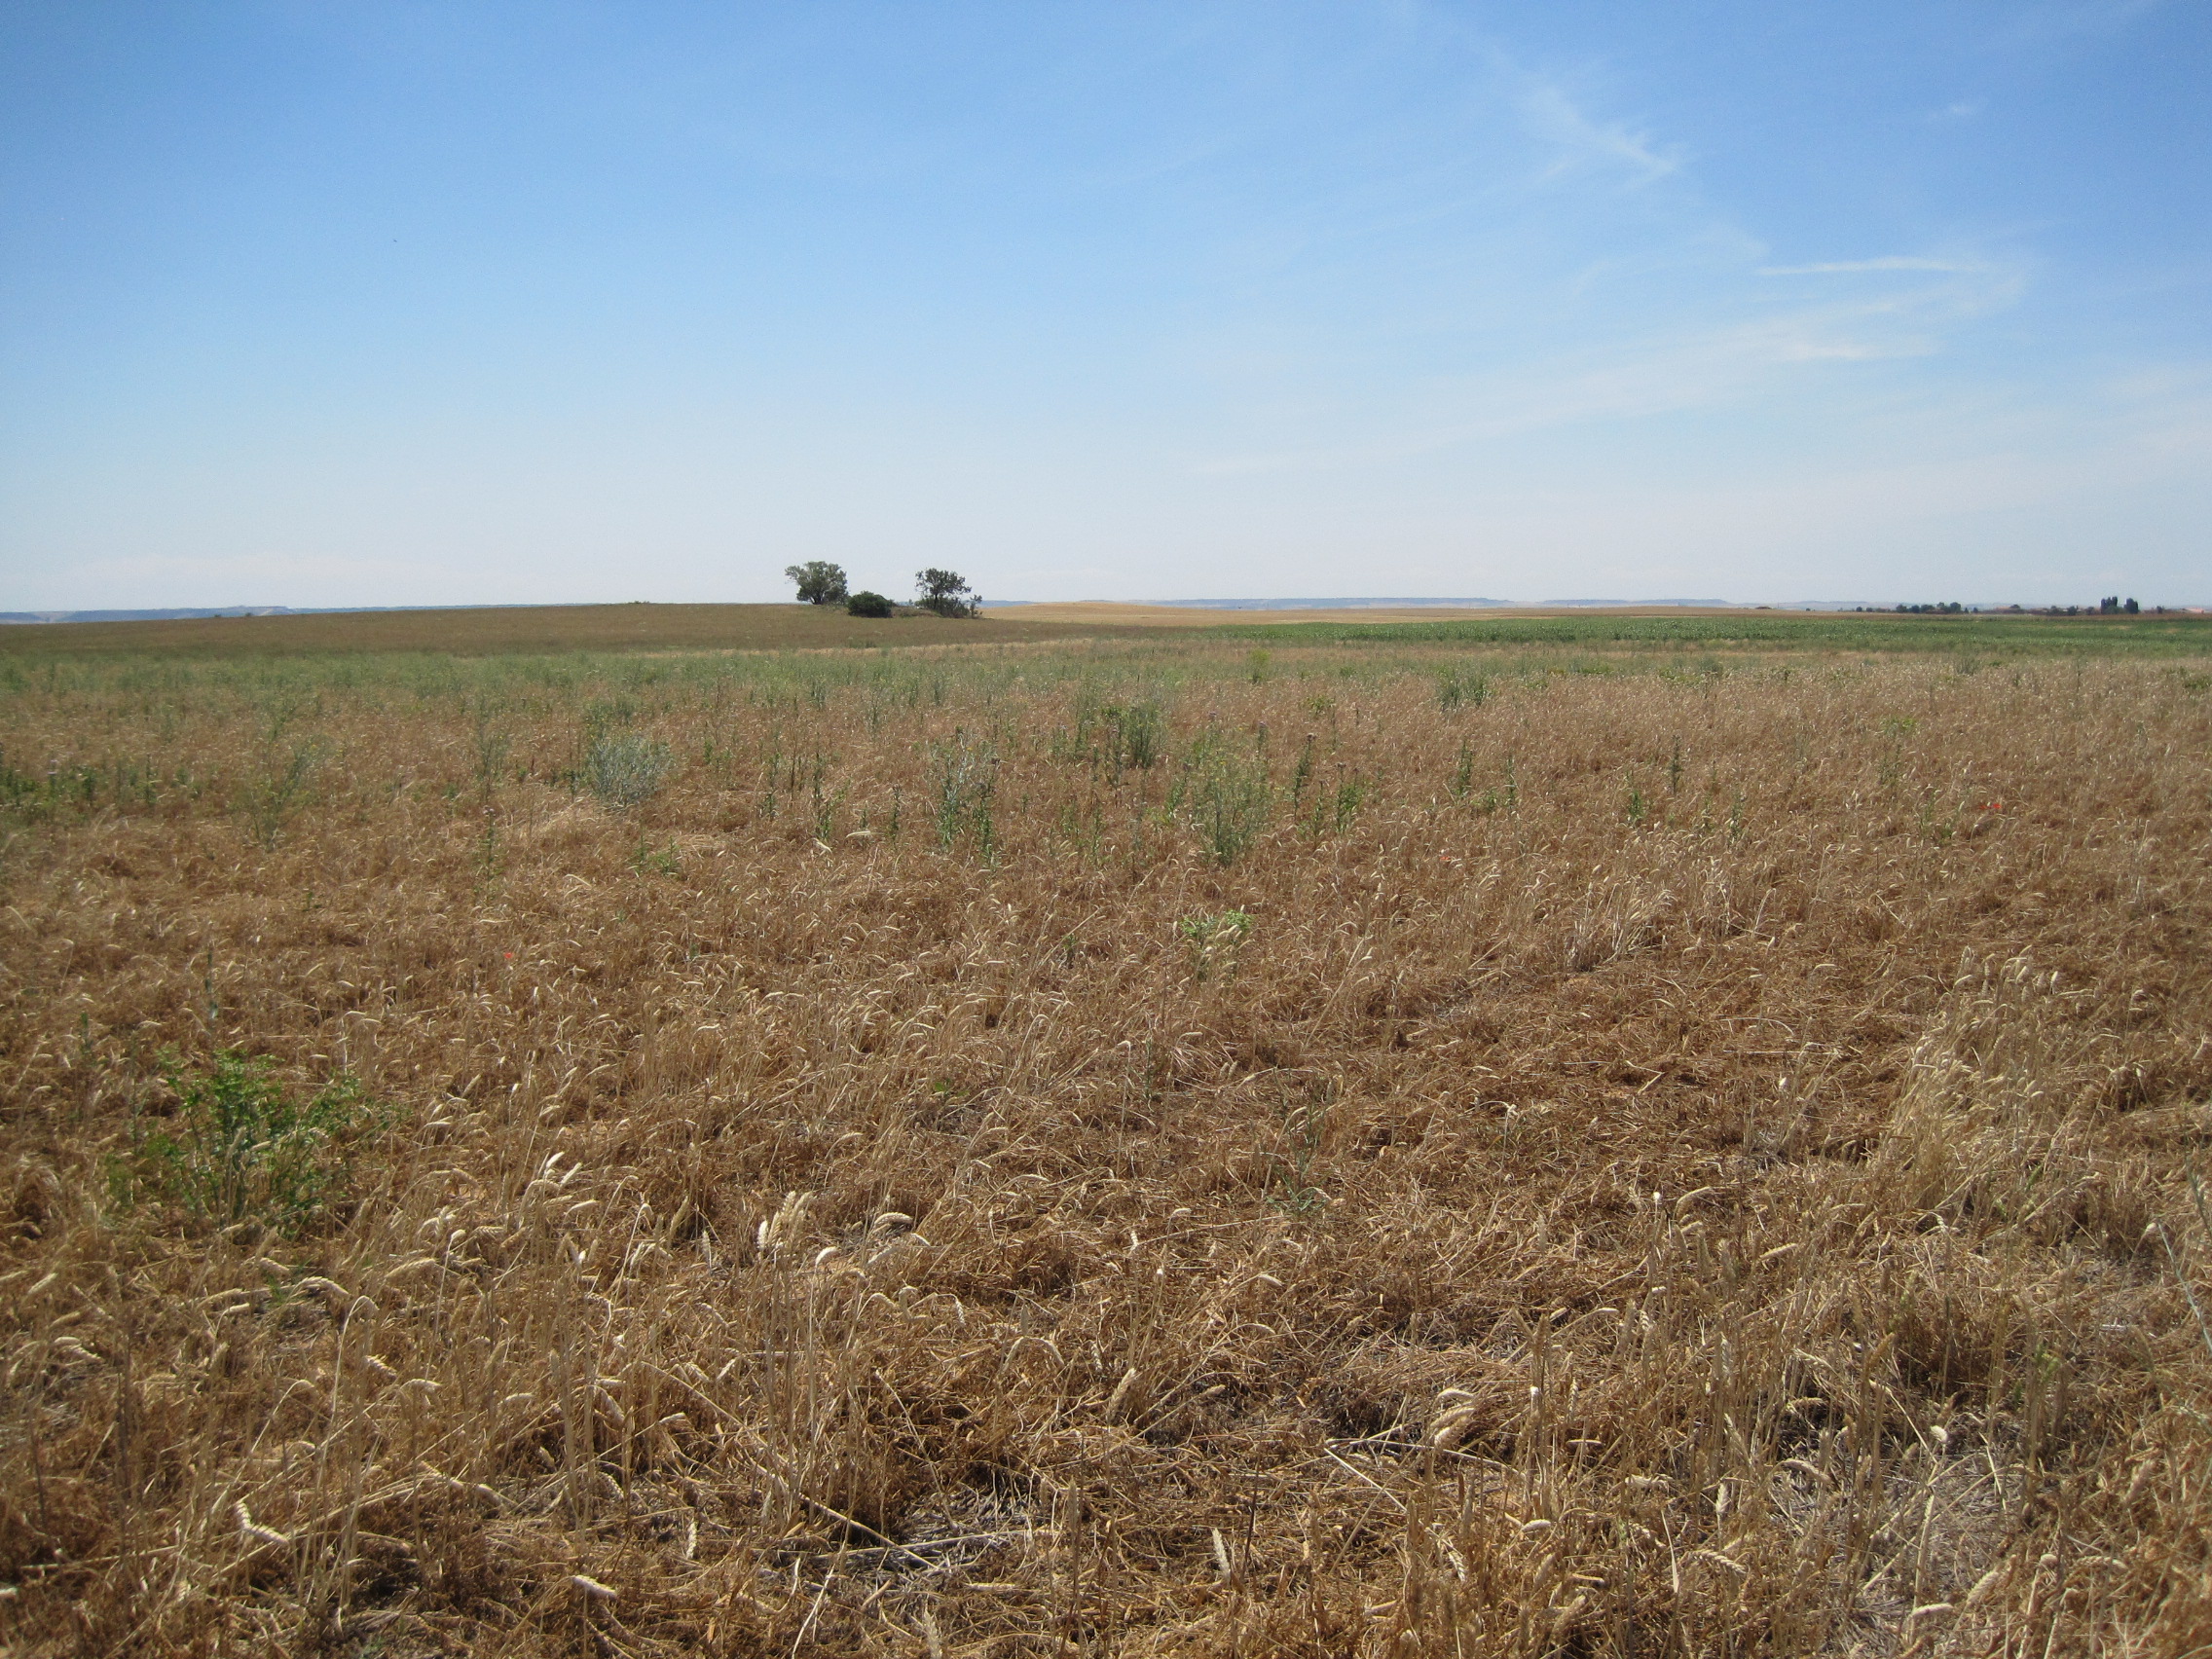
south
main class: Cropland
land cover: Dry pulses
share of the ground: 10 - 25 %
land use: Agriculture (excluding fallow land and kitchen gardens)
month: June
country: ES
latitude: 41.8411
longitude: -5.2430
